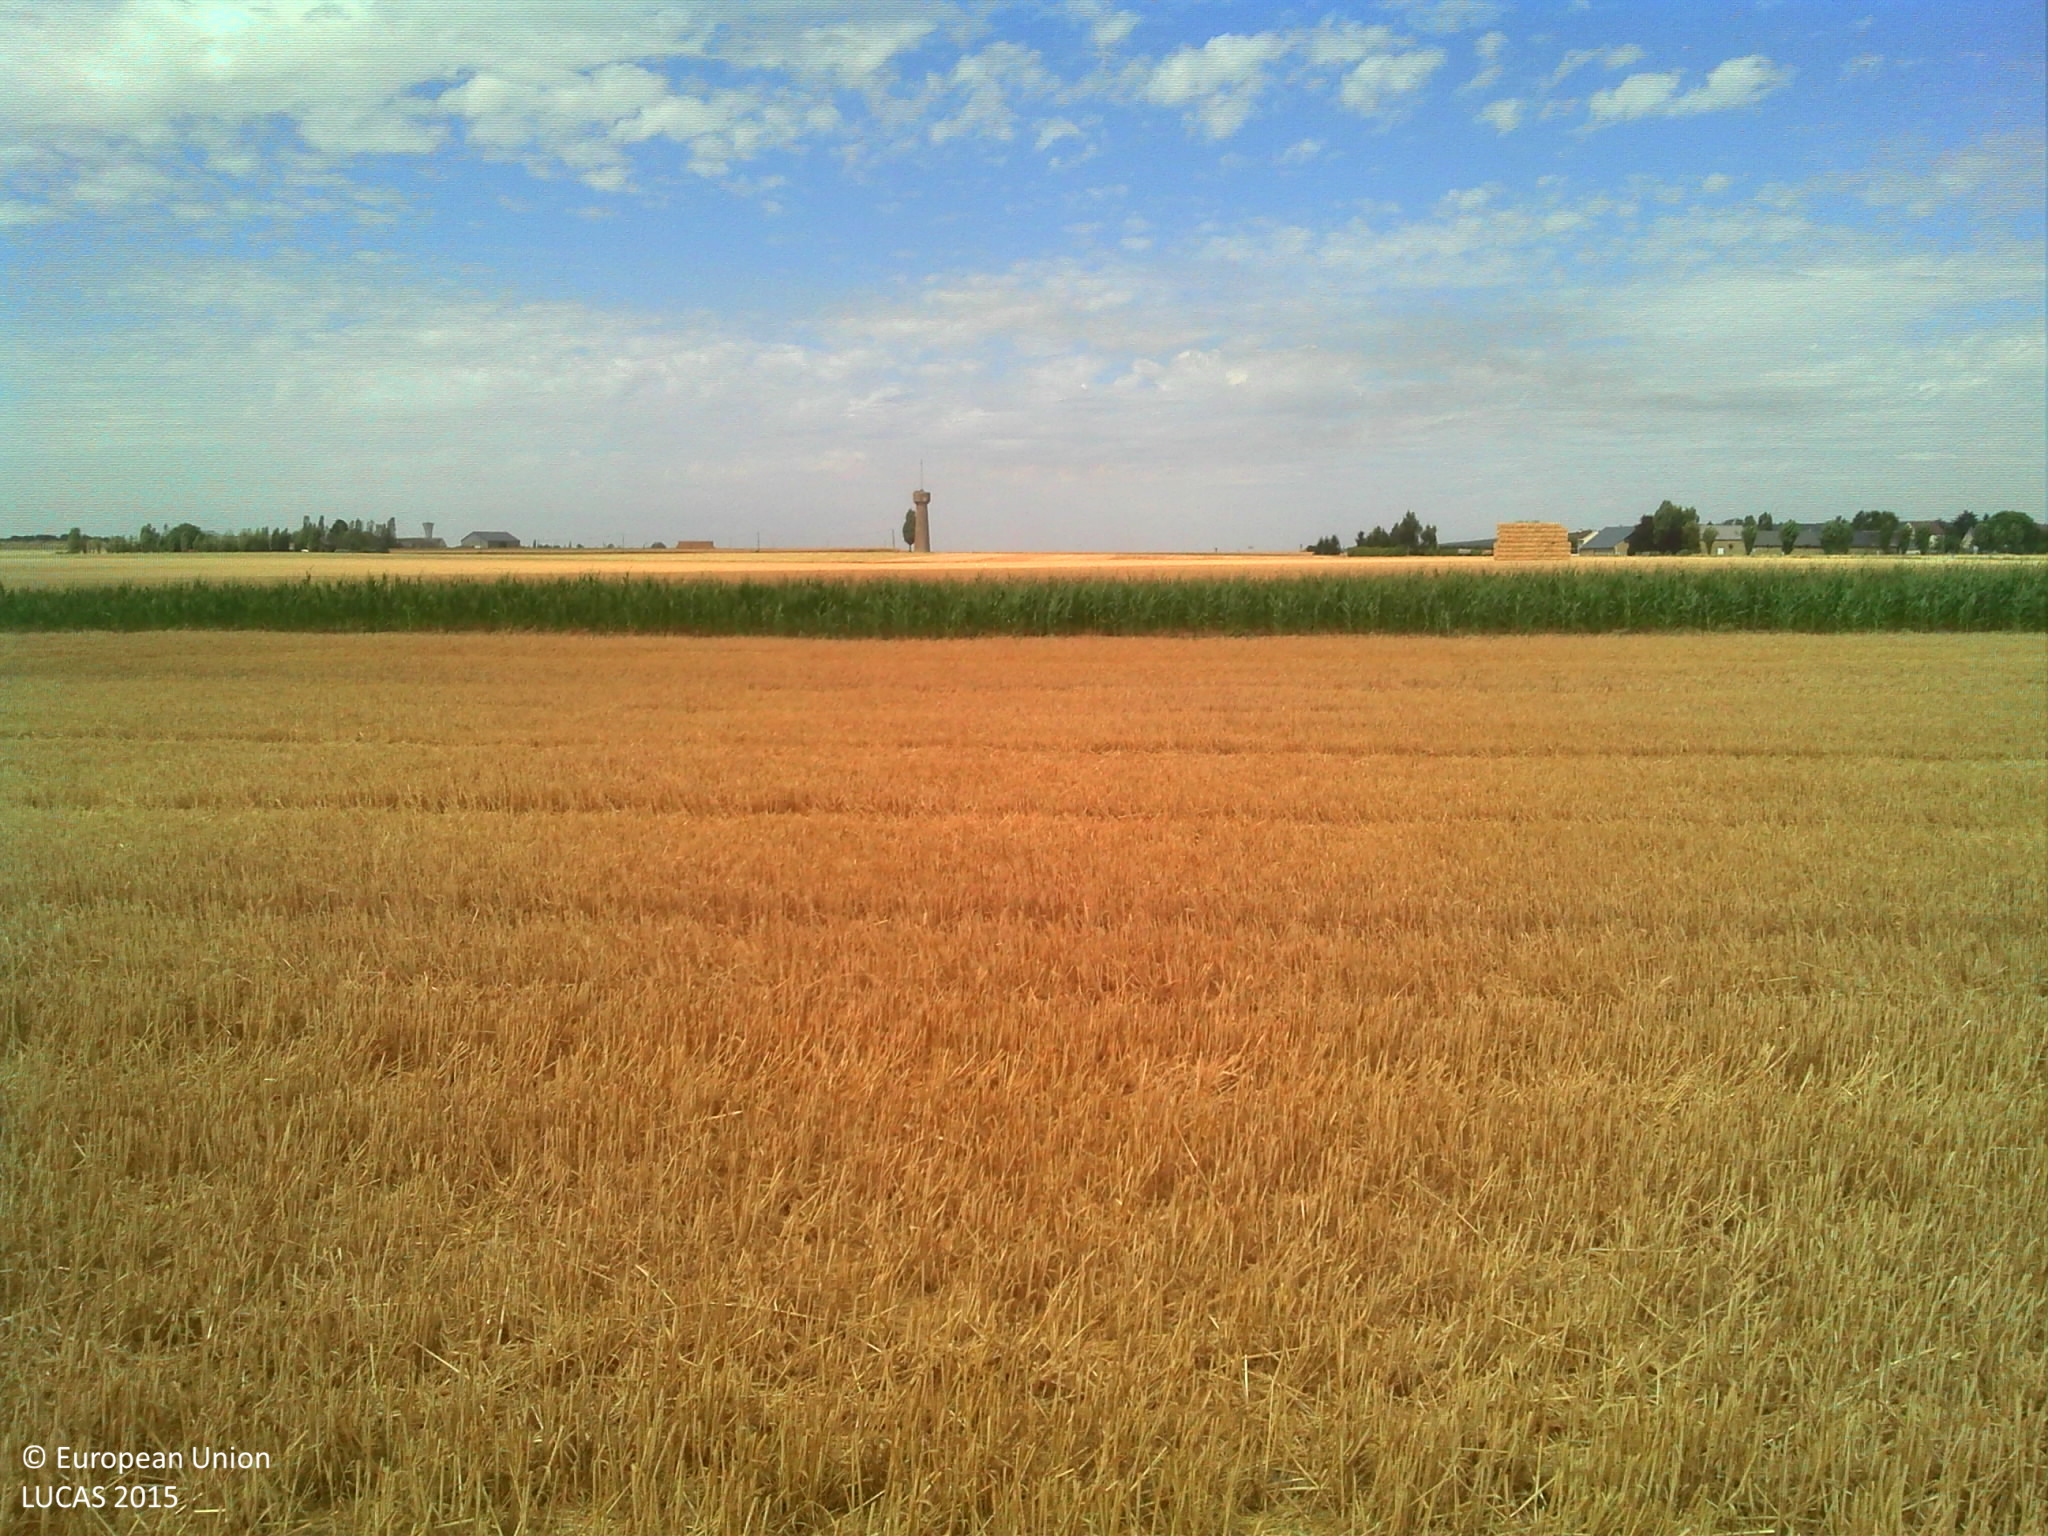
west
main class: Cropland
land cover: Common wheat
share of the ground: > 75 %
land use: Agriculture (excluding fallow land and kitchen gardens)
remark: Harvested field
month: July
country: FR
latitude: 48.4498
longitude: 1.4244
